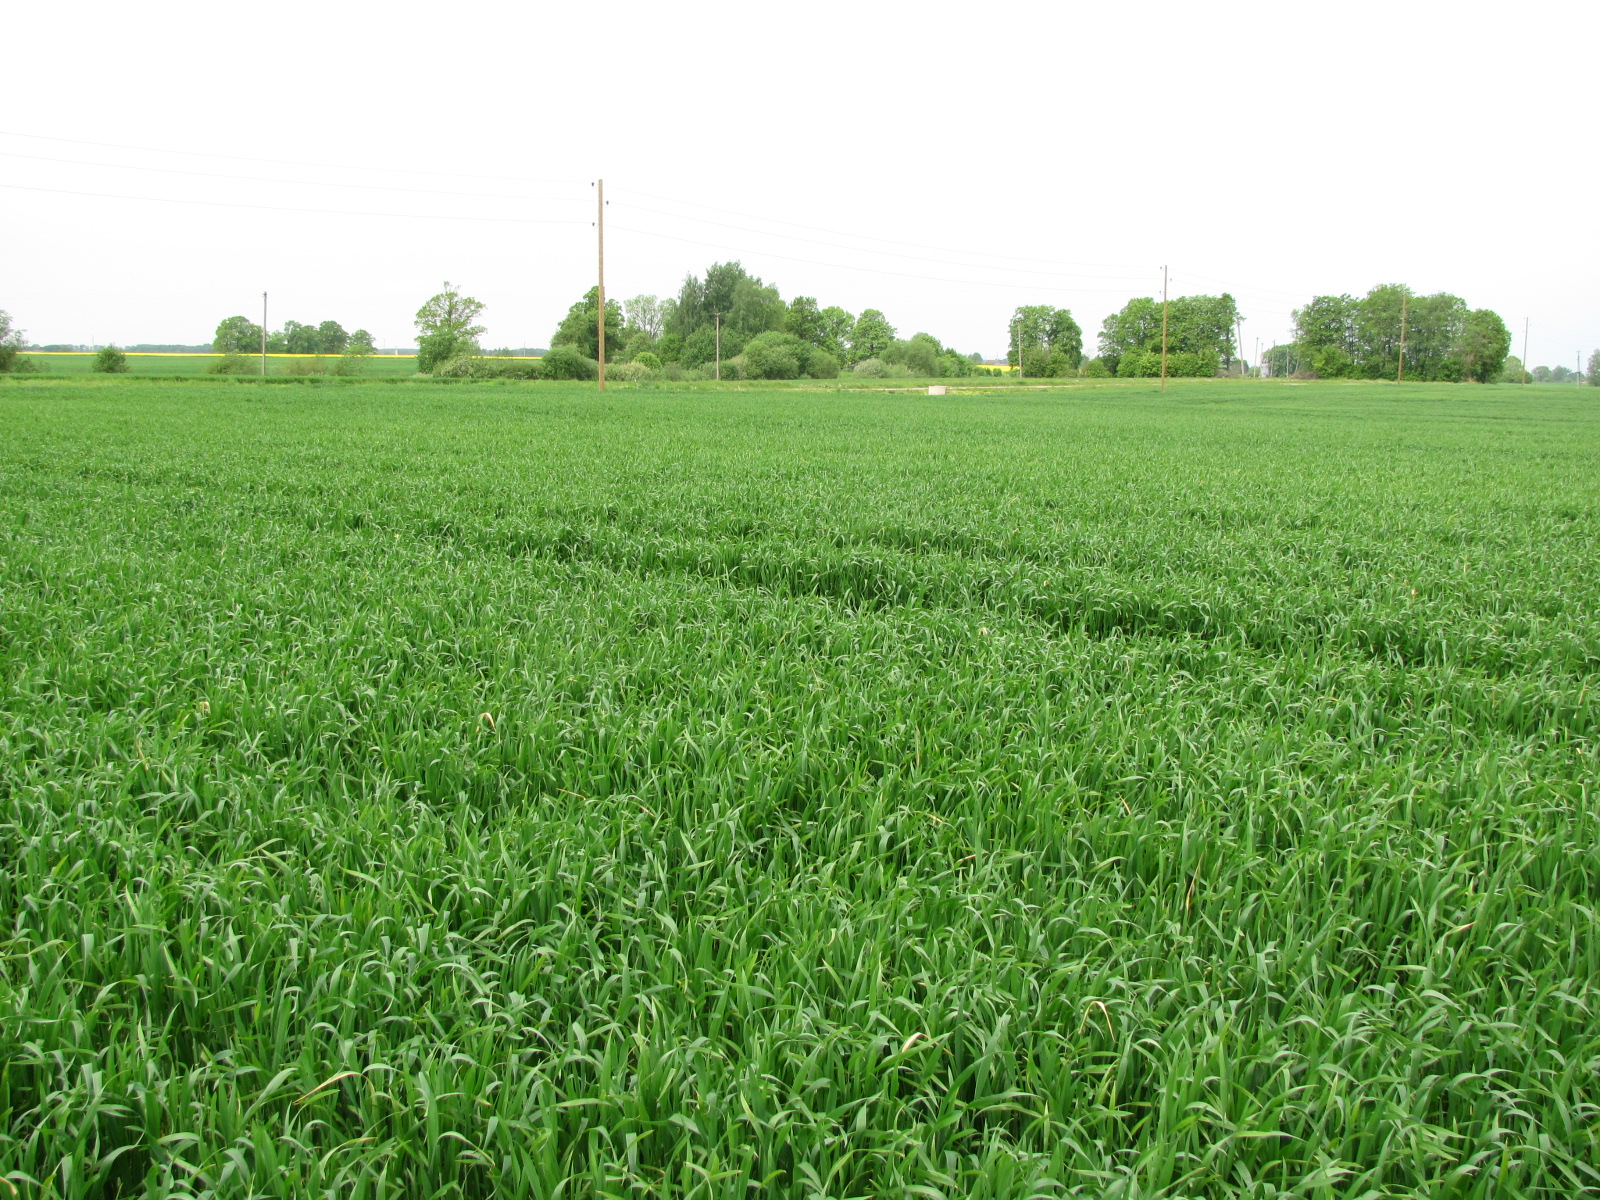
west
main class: Cropland
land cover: Common wheat
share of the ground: > 75 %
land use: Agriculture (excluding fallow land and kitchen gardens)
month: May
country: LV
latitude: 56.4440
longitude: 24.1194
